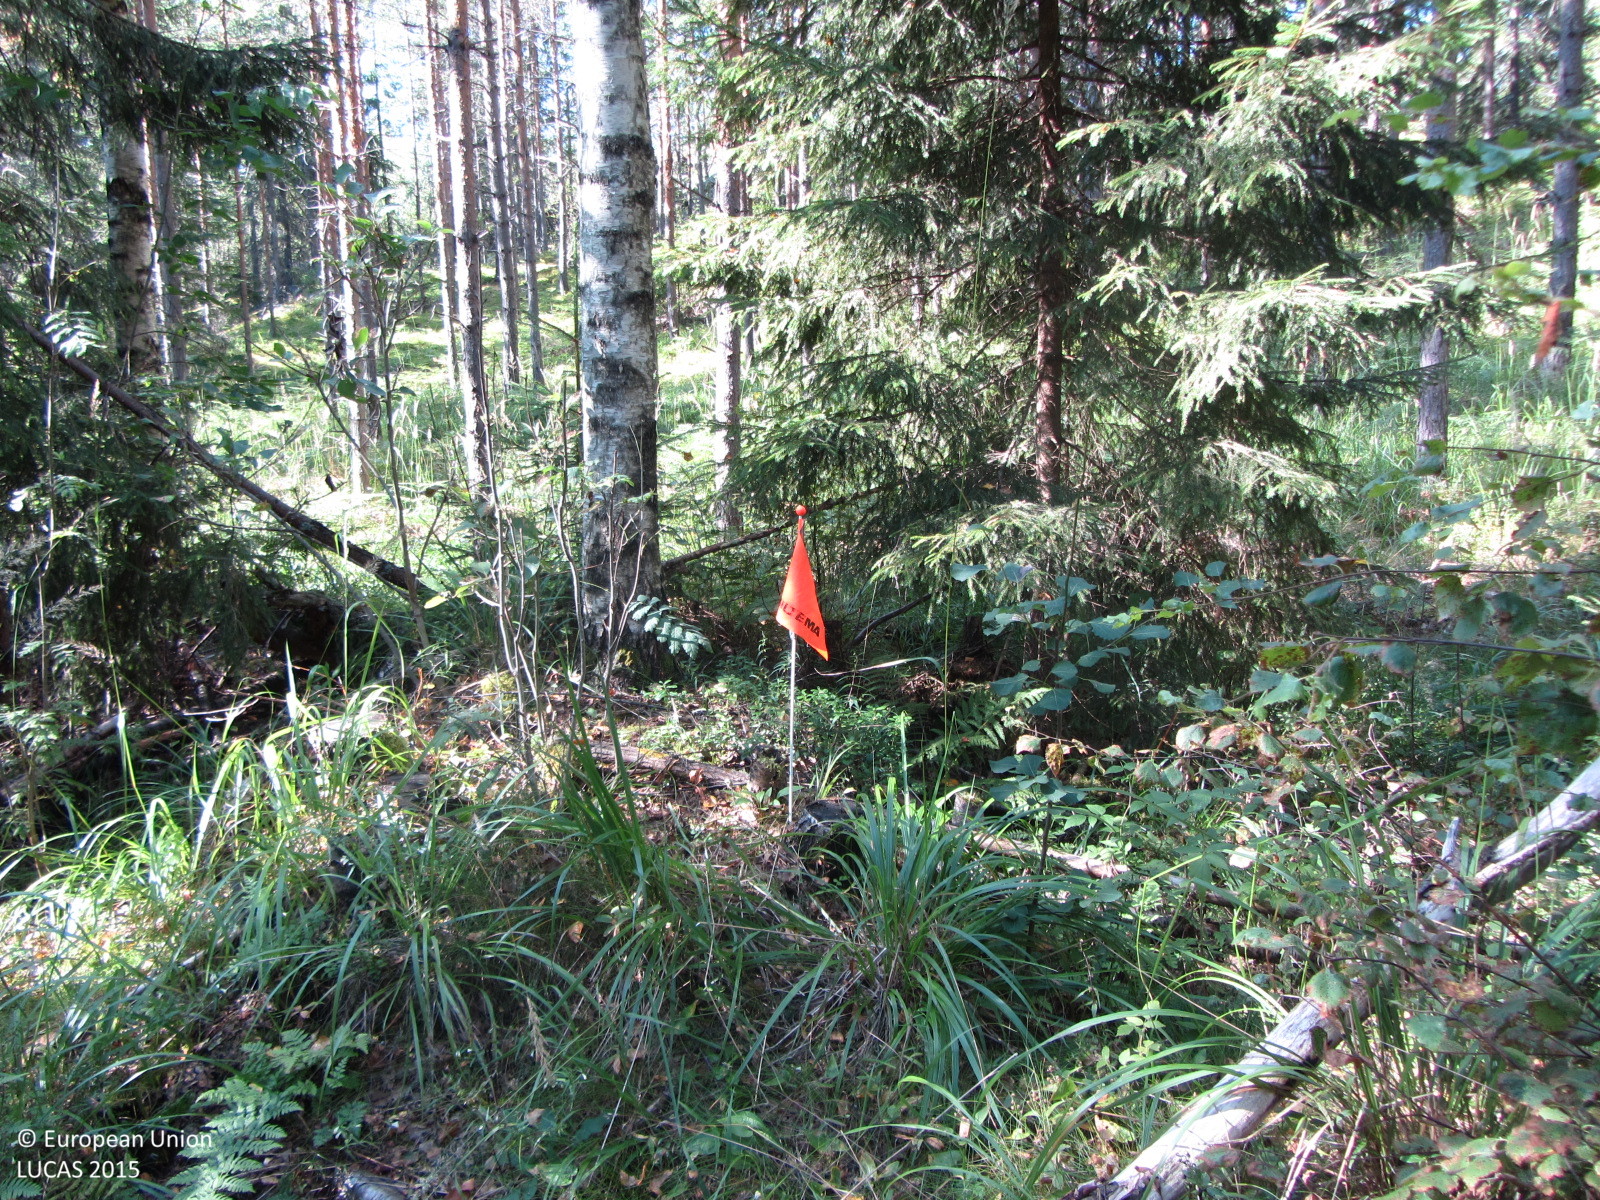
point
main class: Woodland
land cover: Pine dominated mixed woodland
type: boreal forest
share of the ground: 50 - 75 %
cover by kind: coniferous forest trees 50 %, herbaceous plants 25 %, broadleaved forest trees 20 %, shrubs 5 %
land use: Forestry
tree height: > 5 m
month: August
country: FI
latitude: 60.4061
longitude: 23.5025
